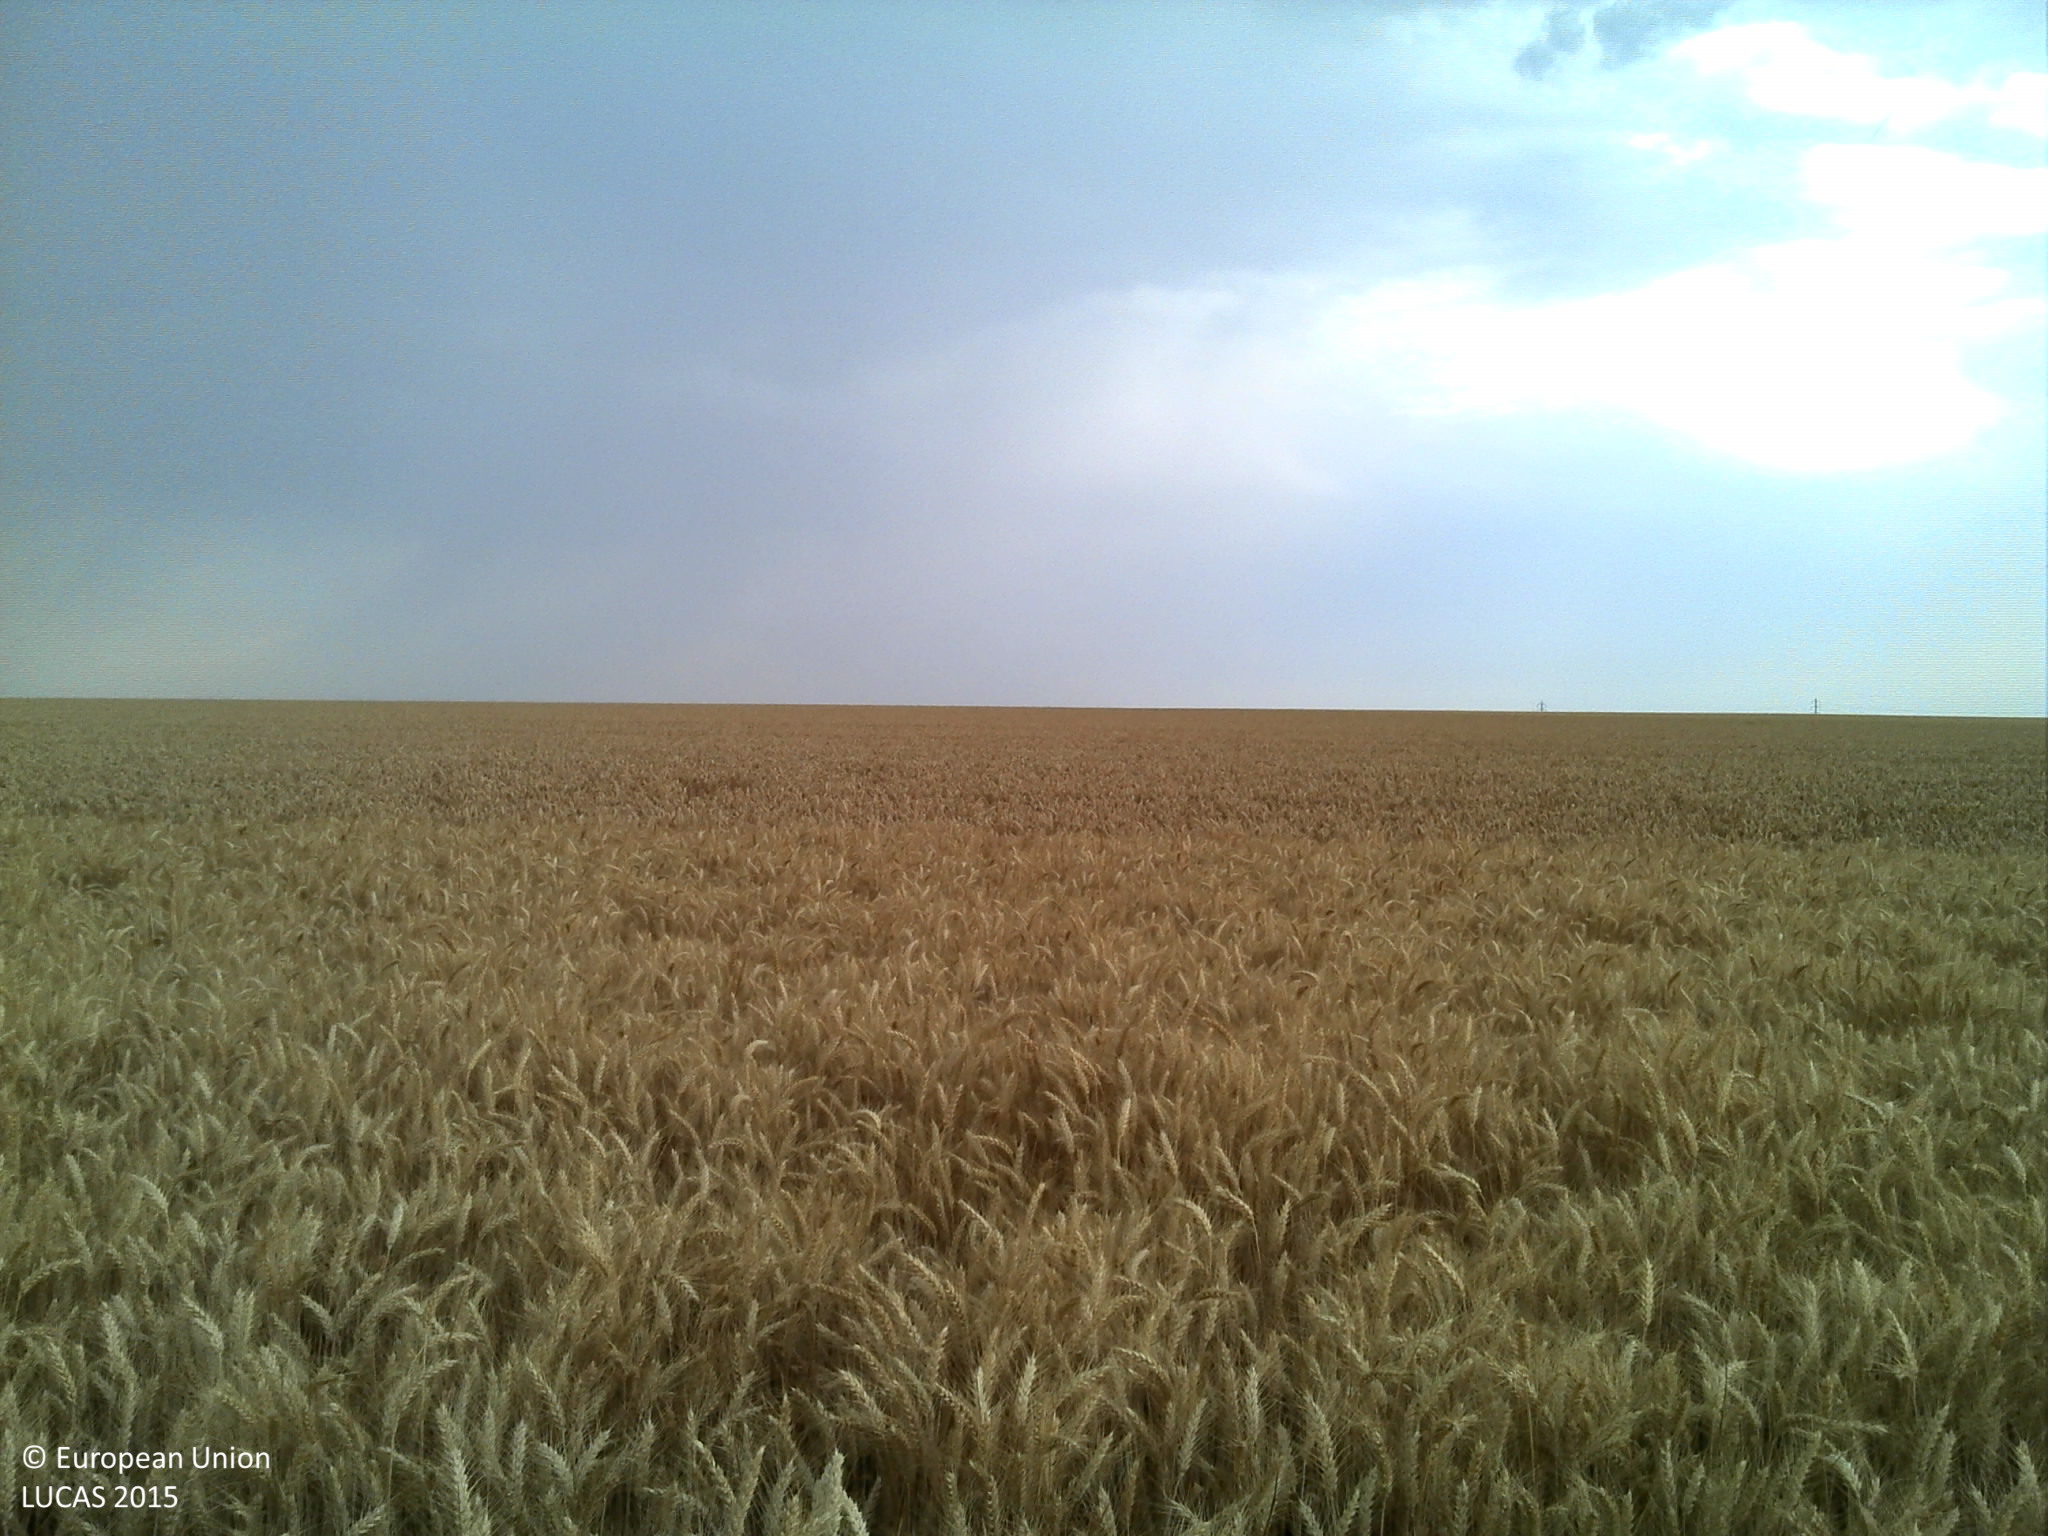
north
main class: Cropland
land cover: Durum wheat
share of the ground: > 75 %
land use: Agriculture (excluding fallow land and kitchen gardens)
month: July
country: FR
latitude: 48.3259
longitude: 2.4499
